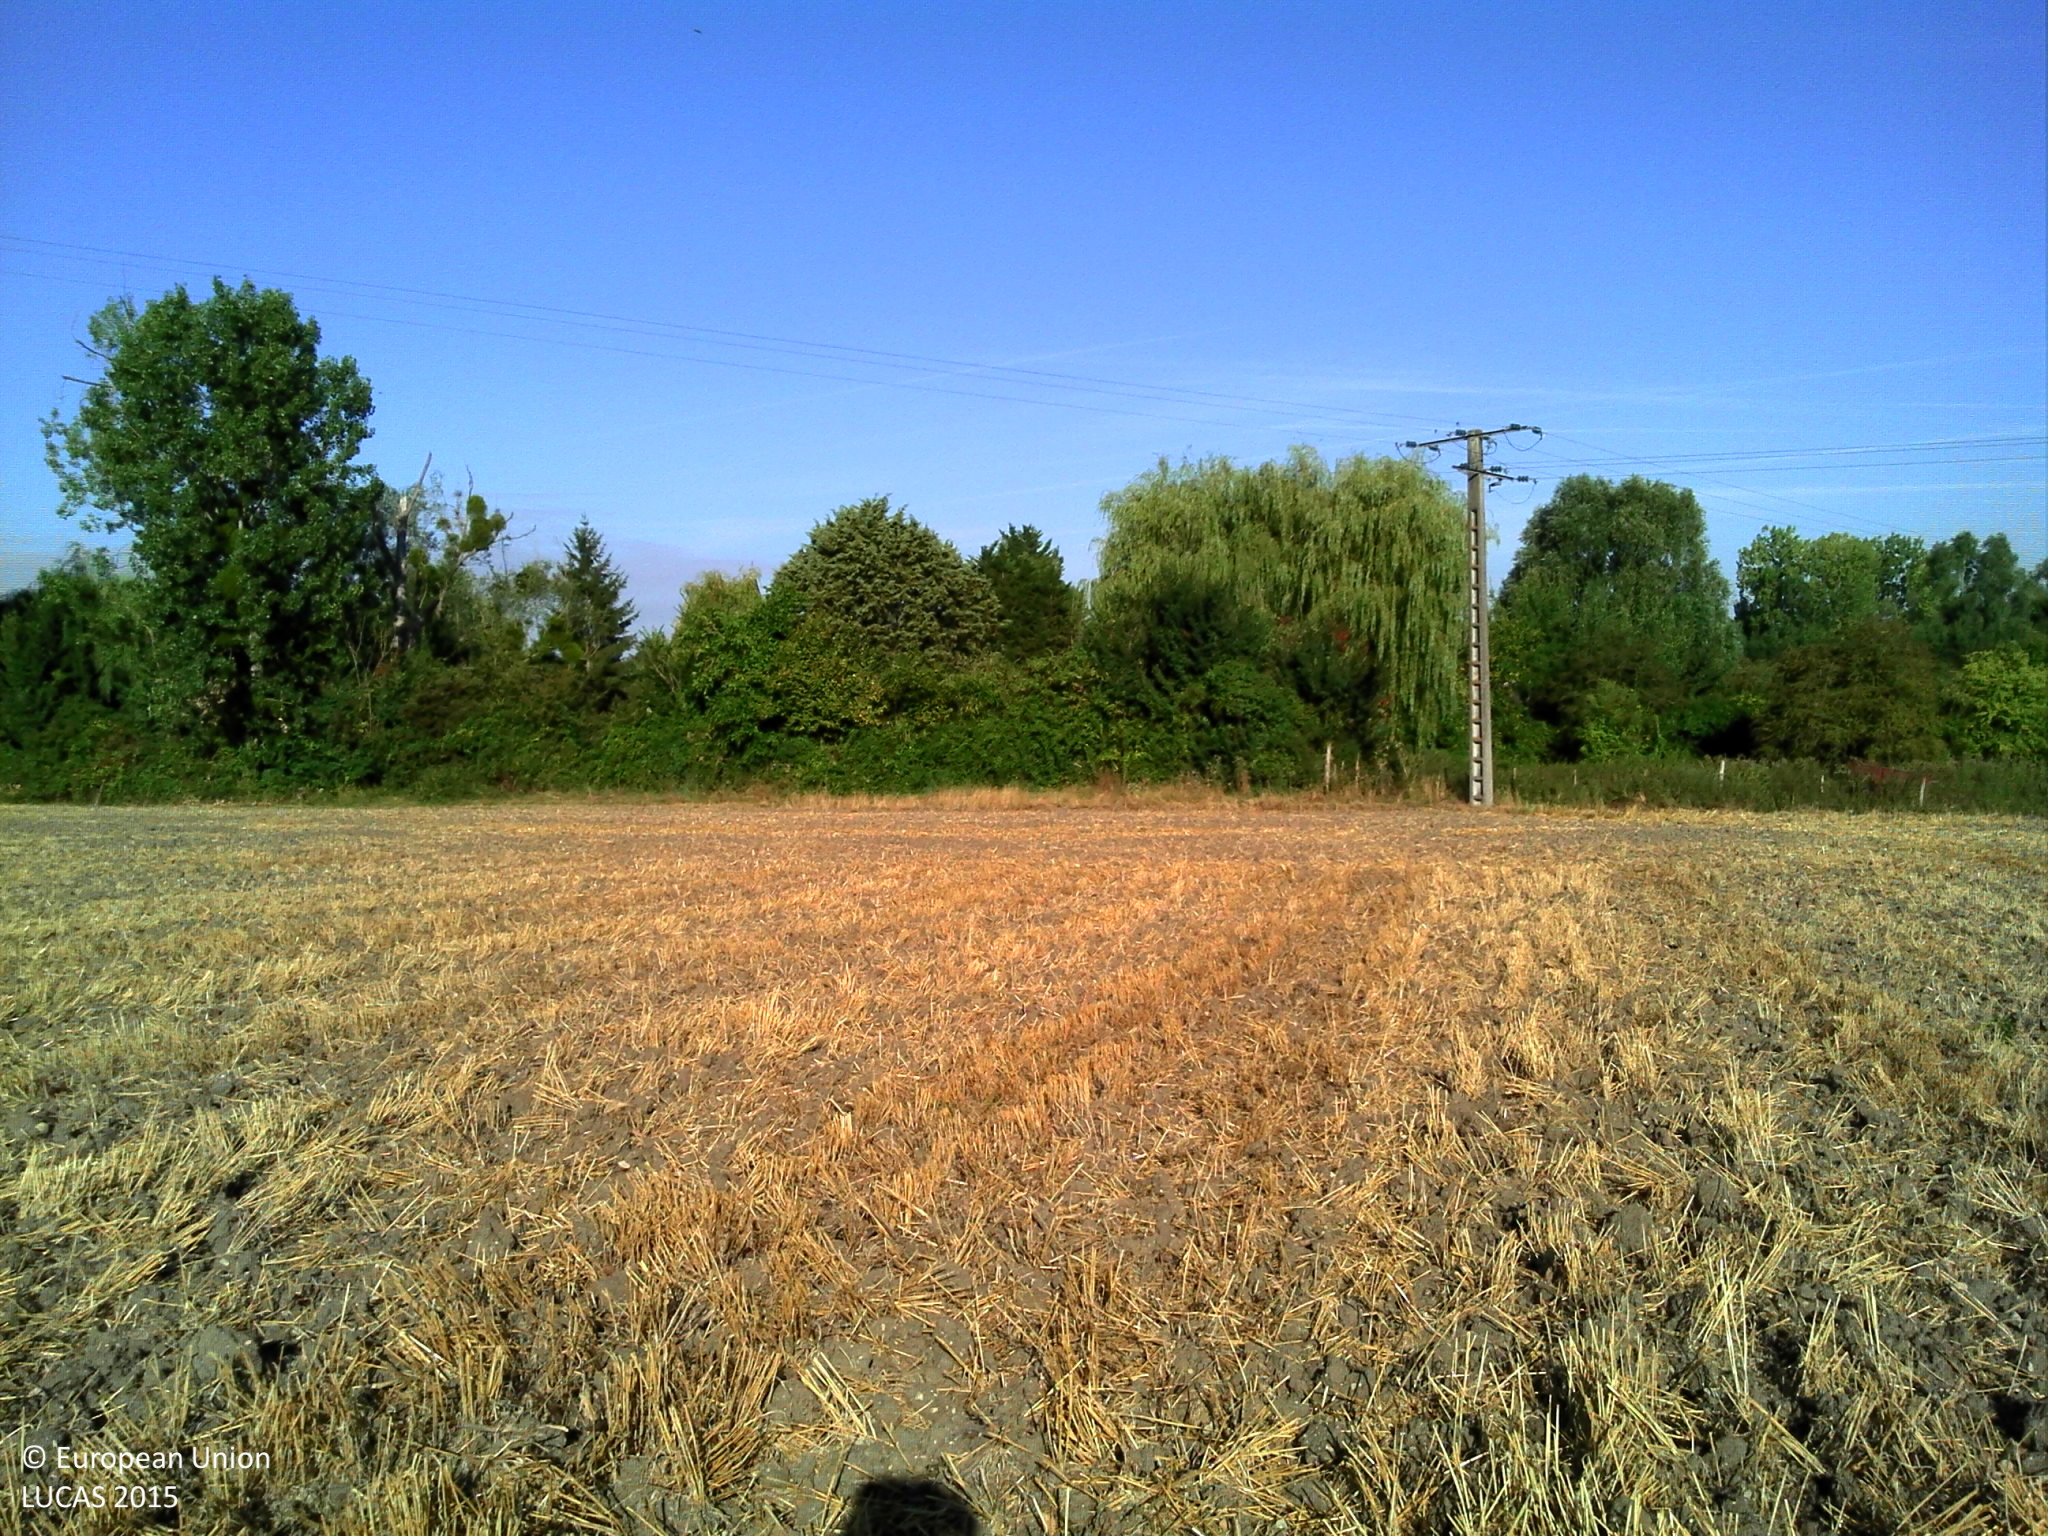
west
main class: Cropland
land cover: Common wheat
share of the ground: 25 - 50 %
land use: Agriculture (excluding fallow land and kitchen gardens)
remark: Tilled/Sowed
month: August
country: FR
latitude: 46.8387
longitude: 0.5542
